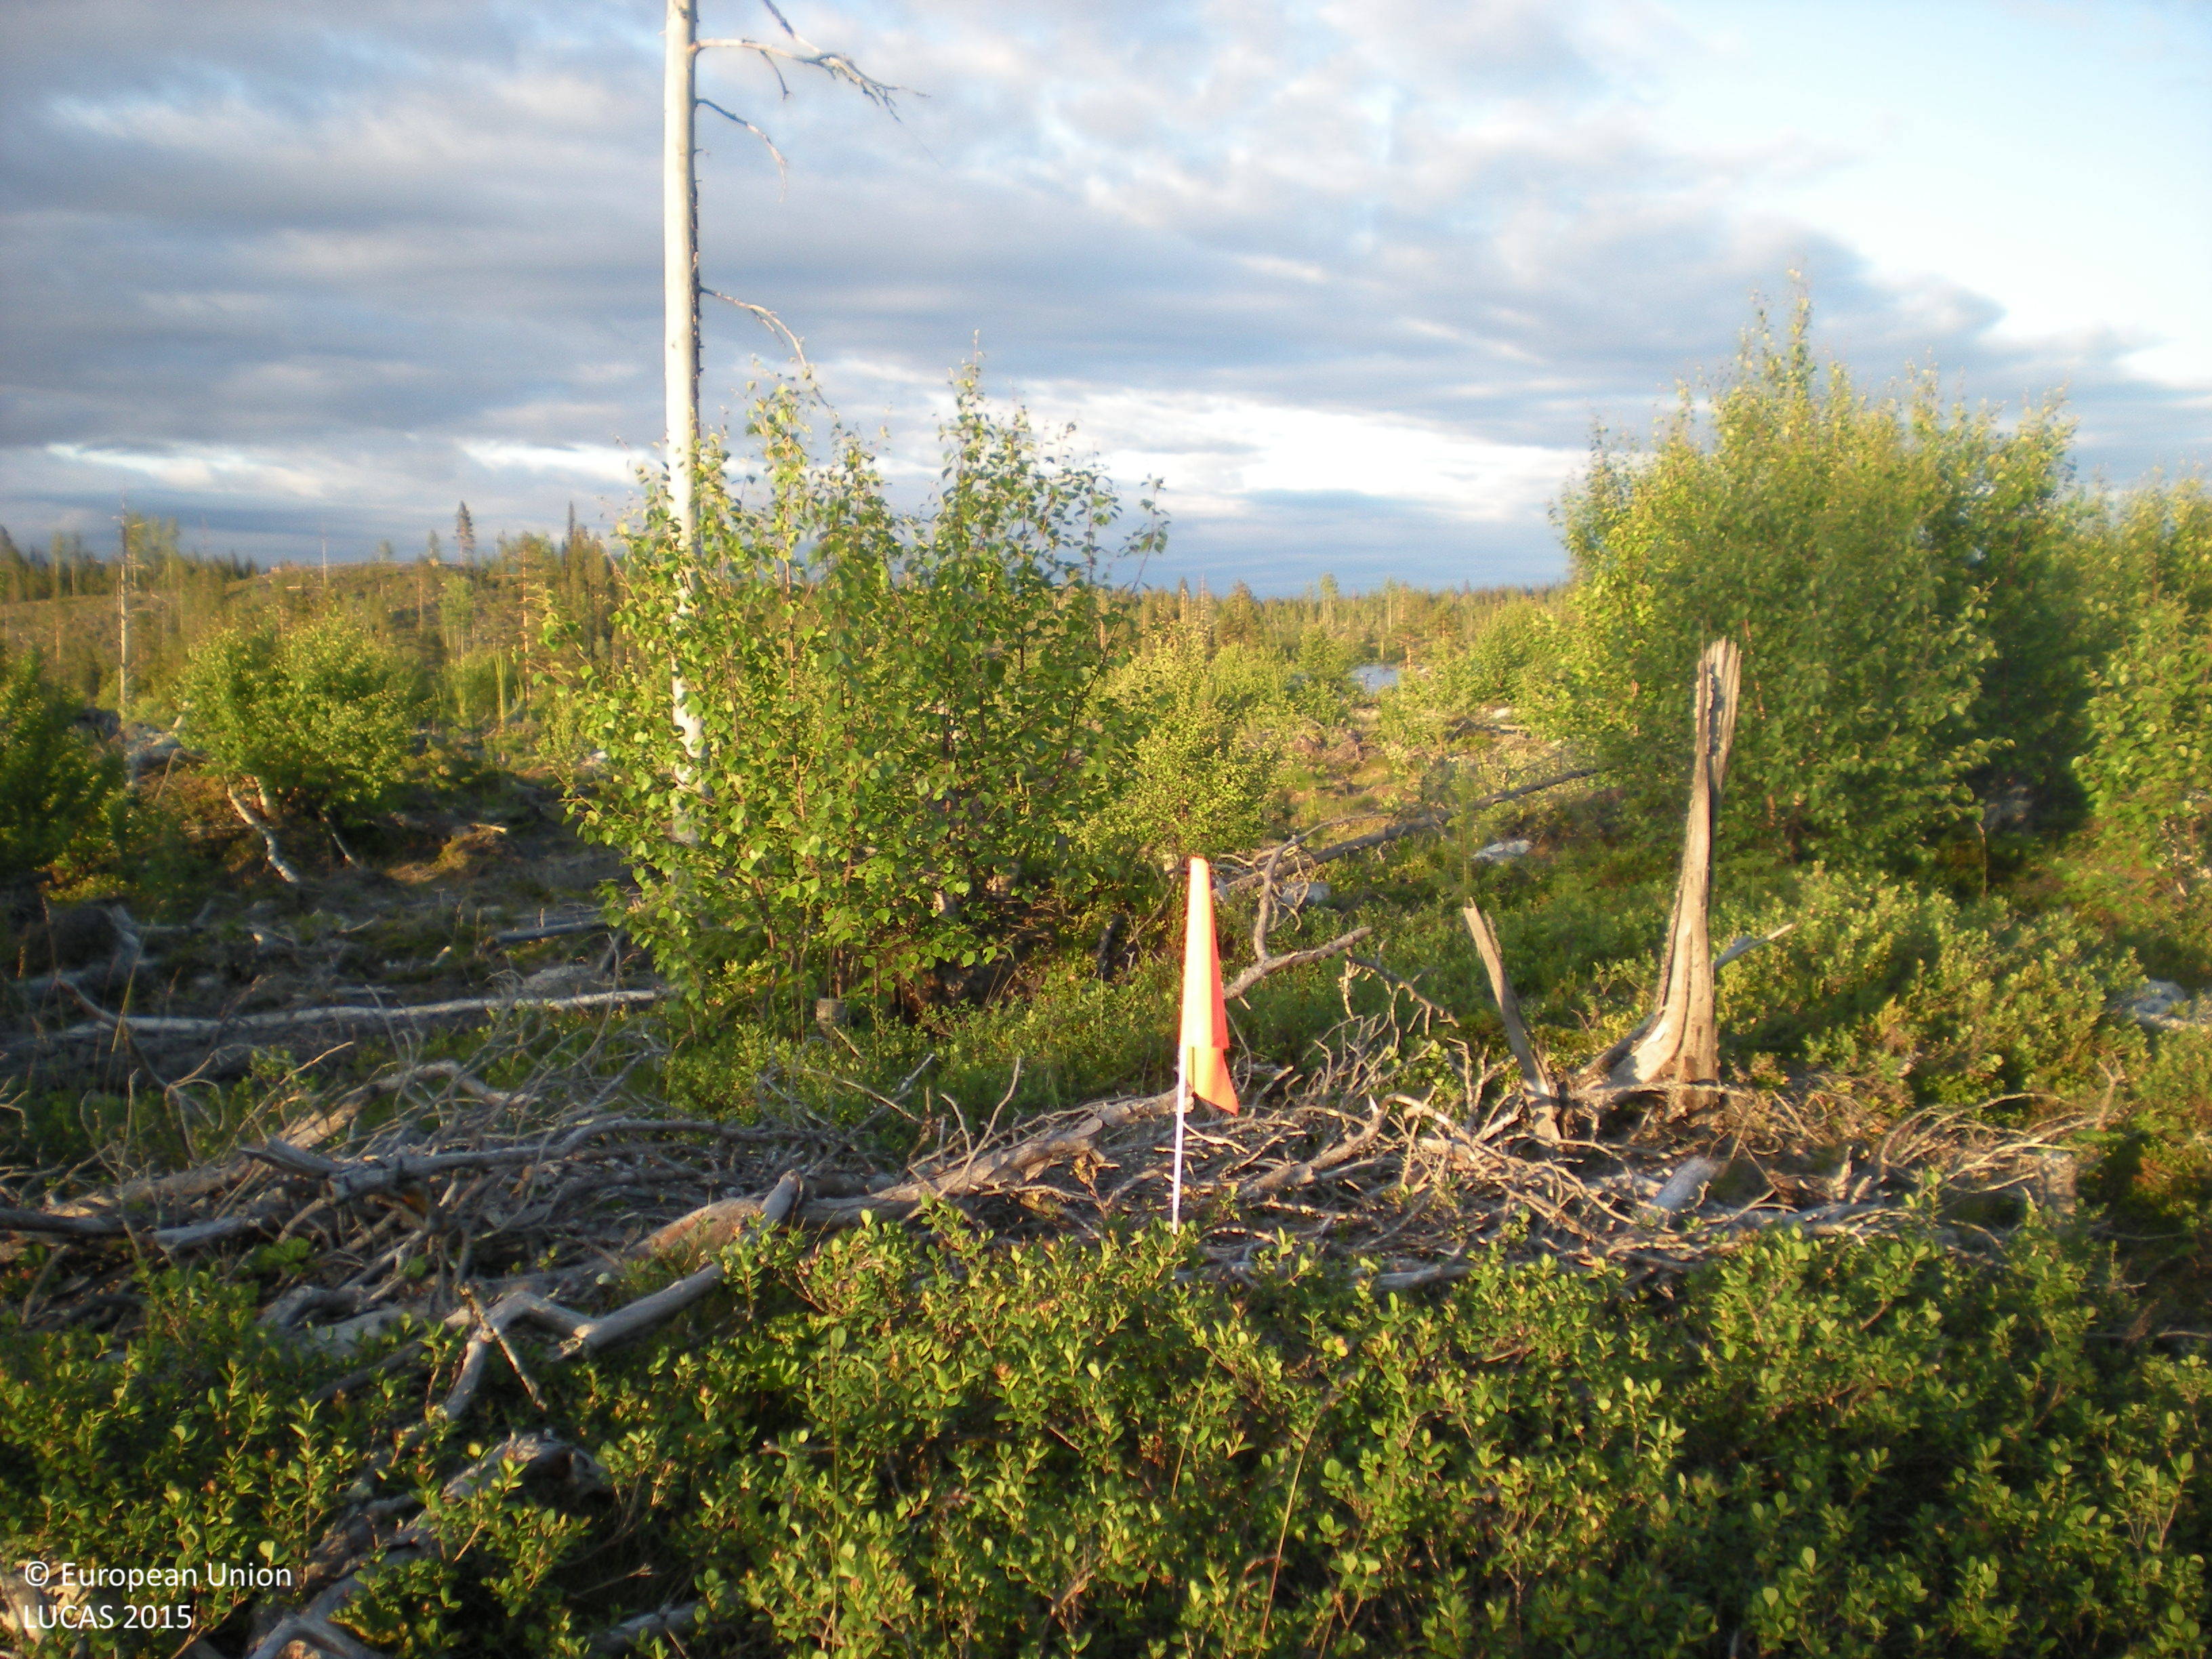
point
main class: Woodland
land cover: Broadleaved woodland
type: boreal forest
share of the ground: 25 - 50 %
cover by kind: shrubs 60 %, broadleaved forest trees 25 %, coniferous forest trees 5 %, lichens and mosses 5 %
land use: Forestry
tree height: < 5 m
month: July
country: SE
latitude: 65.5684
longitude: 17.0020
